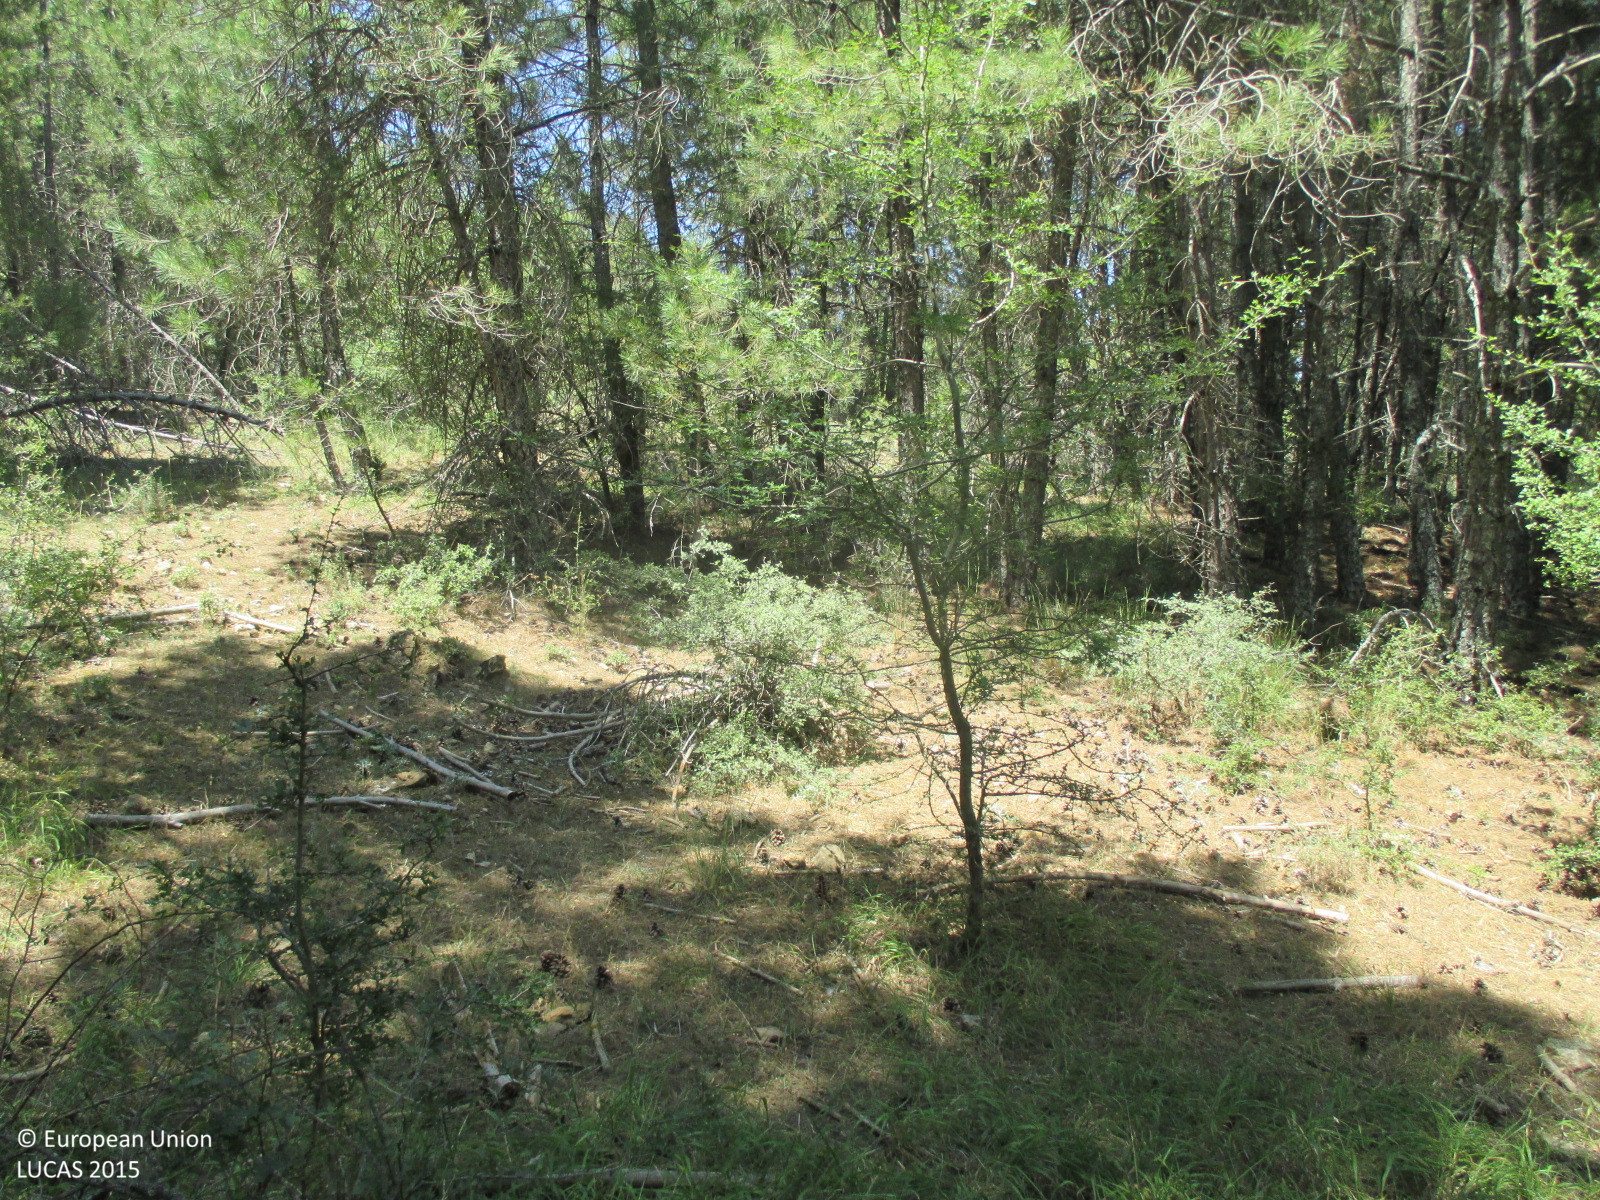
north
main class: Woodland
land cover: Pine dominated coniferous woodland
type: coniferous forest of the mediterranean region
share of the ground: > 75 %
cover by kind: coniferous forest trees 90 %, shrubs 5 %, herbaceous plants 5 %
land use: Forestry
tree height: > 5 m
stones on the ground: < 10 %
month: July
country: ES
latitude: 38.3032
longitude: -2.5643
